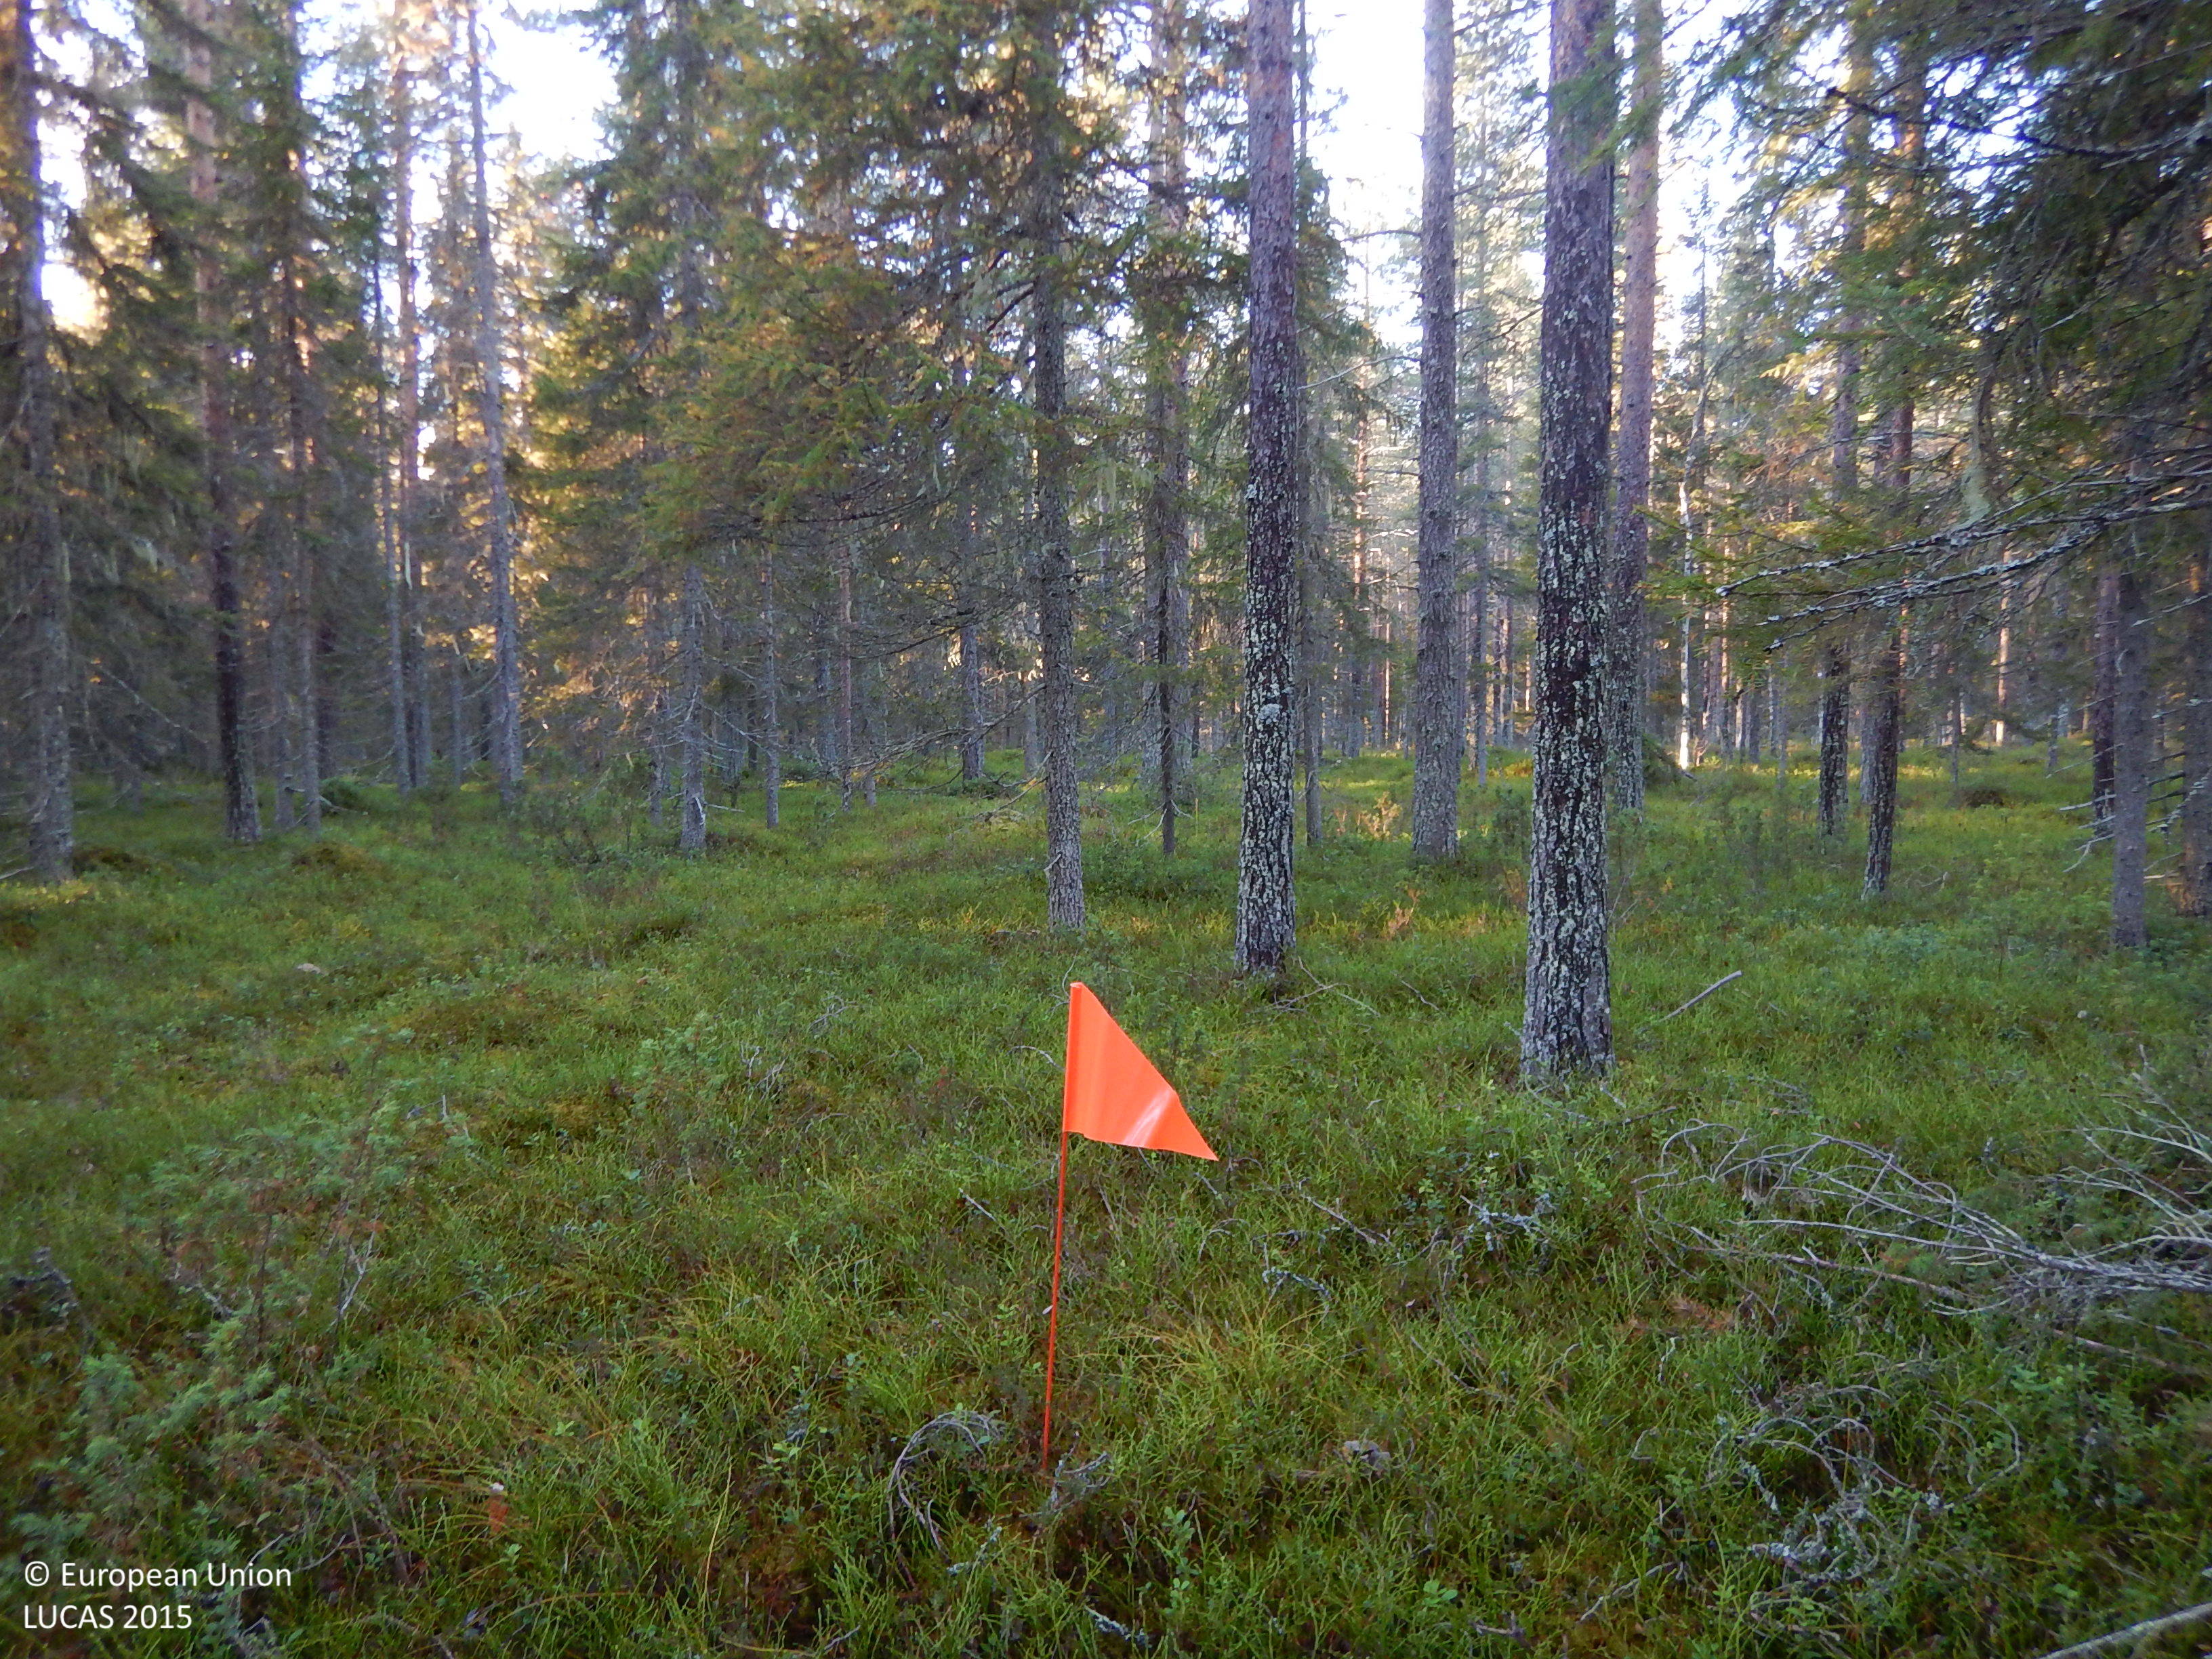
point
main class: Woodland
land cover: Other coniferous woodland
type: boreal forest
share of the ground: 50 - 75 %
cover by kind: coniferous forest trees 65 %, shrubs 15 %, lichens and mosses 15 %, herbaceous plants 5 %
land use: Forestry
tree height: > 5 m
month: November
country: SE
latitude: 65.2875
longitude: 21.0994
